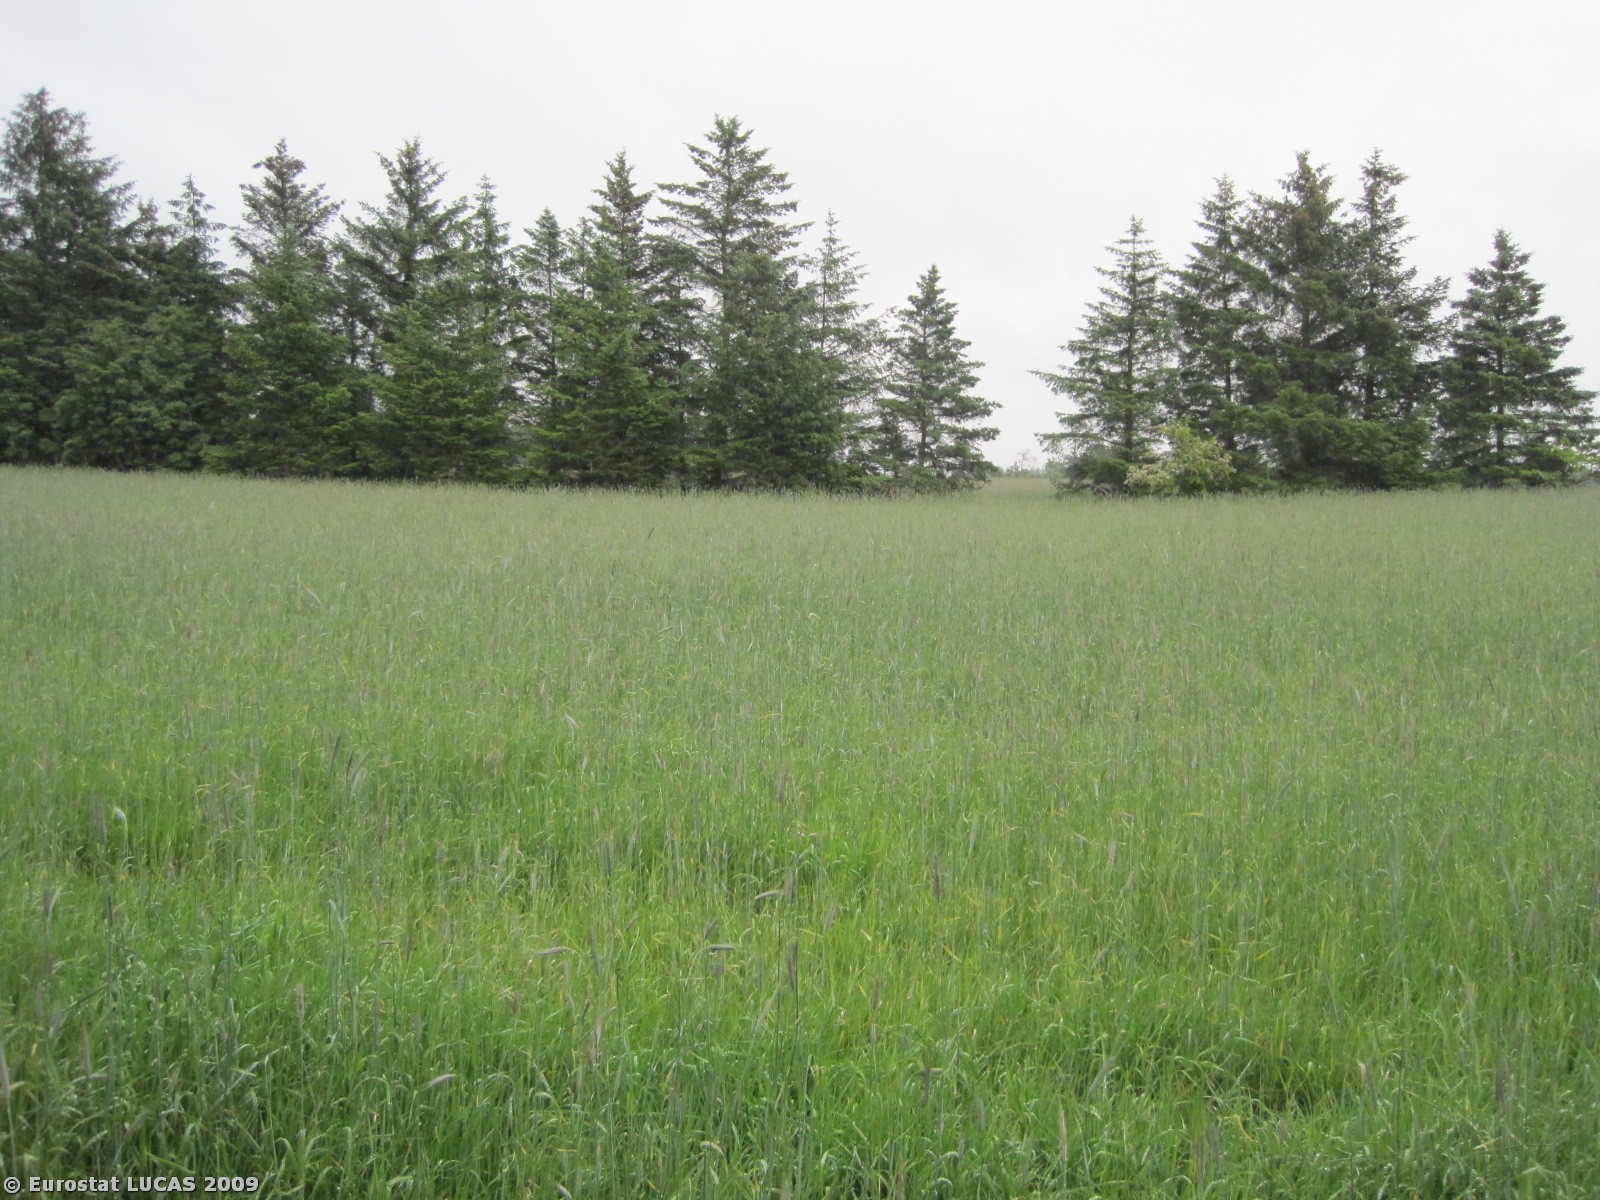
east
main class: Grassland
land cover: Grassland without tree/shrub cover
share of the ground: > 75 %
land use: Agriculture (excluding fallow land and kitchen gardens)
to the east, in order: Grassland without tree/shrub cover; Tracks; Grassland without tree/shrub cover; Abandoned hedges; Grassland without tree/shrub cover; Abandoned hedges; Grassland without tree/shrub cover; Grass margins; Rye; Grass margins; Abandoned hedges; Barley
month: June
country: DK
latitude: 57.4641
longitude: 10.1498
